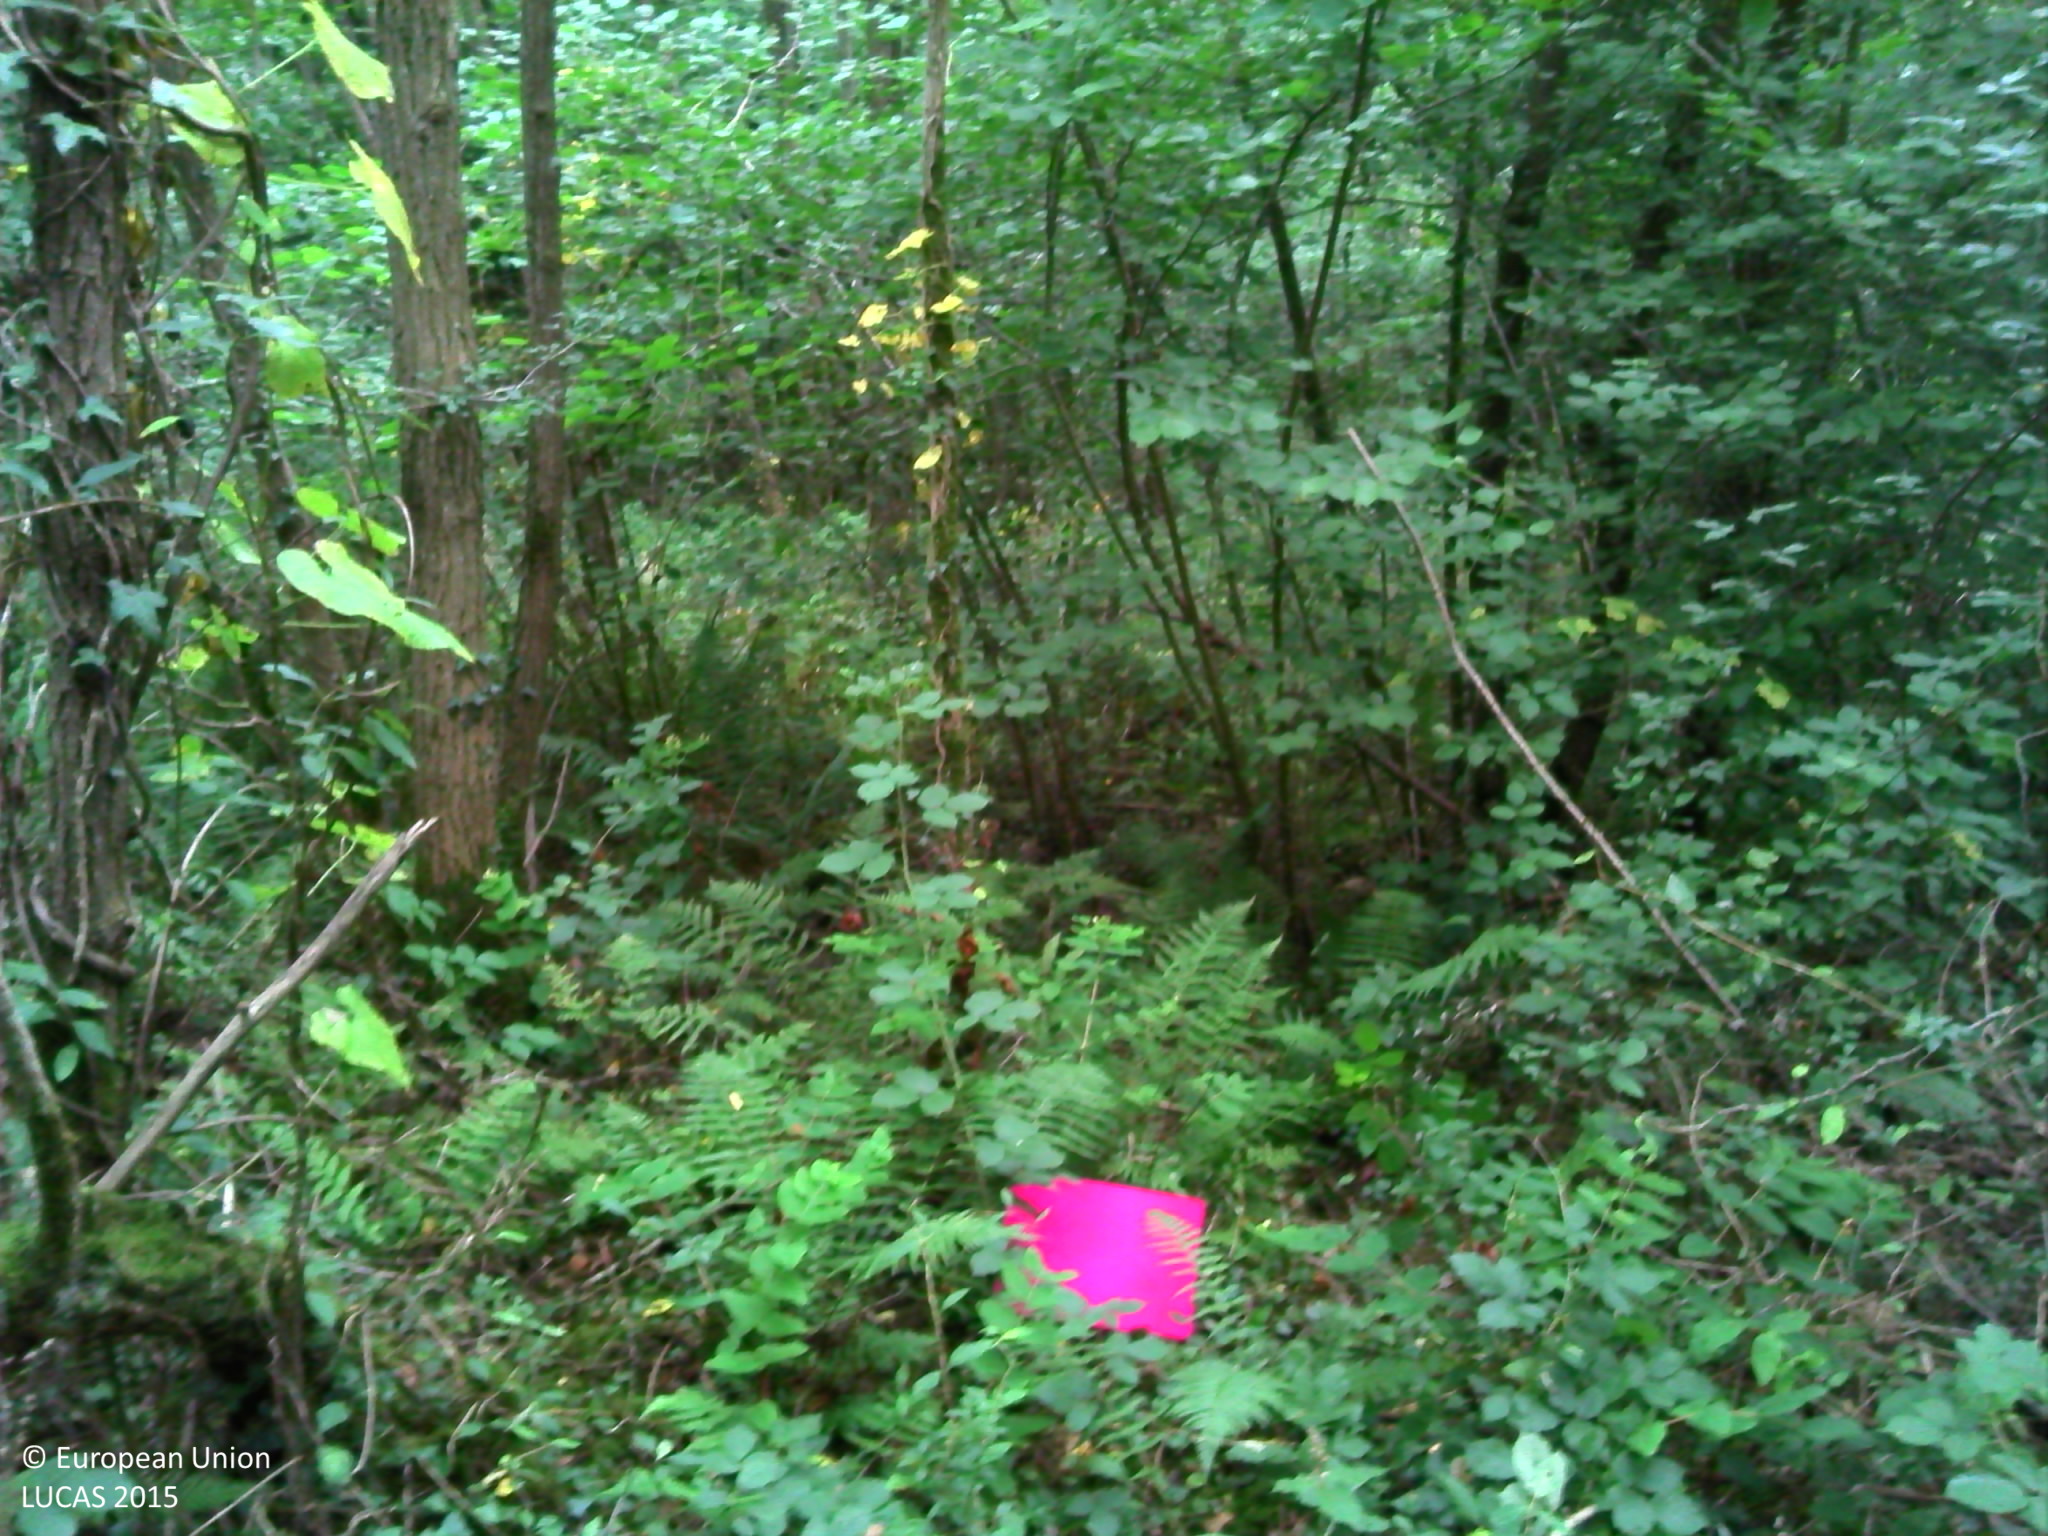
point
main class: Woodland
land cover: Broadleaved woodland
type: thermophilous deciduous forest
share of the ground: > 75 %
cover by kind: broadleaved forest trees 80 %, shrubs 10 %, herbaceous plants 5 %, lichens and mosses 5 %
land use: Forestry
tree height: > 5 m
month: August
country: FR
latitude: 43.3371
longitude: -1.0771
